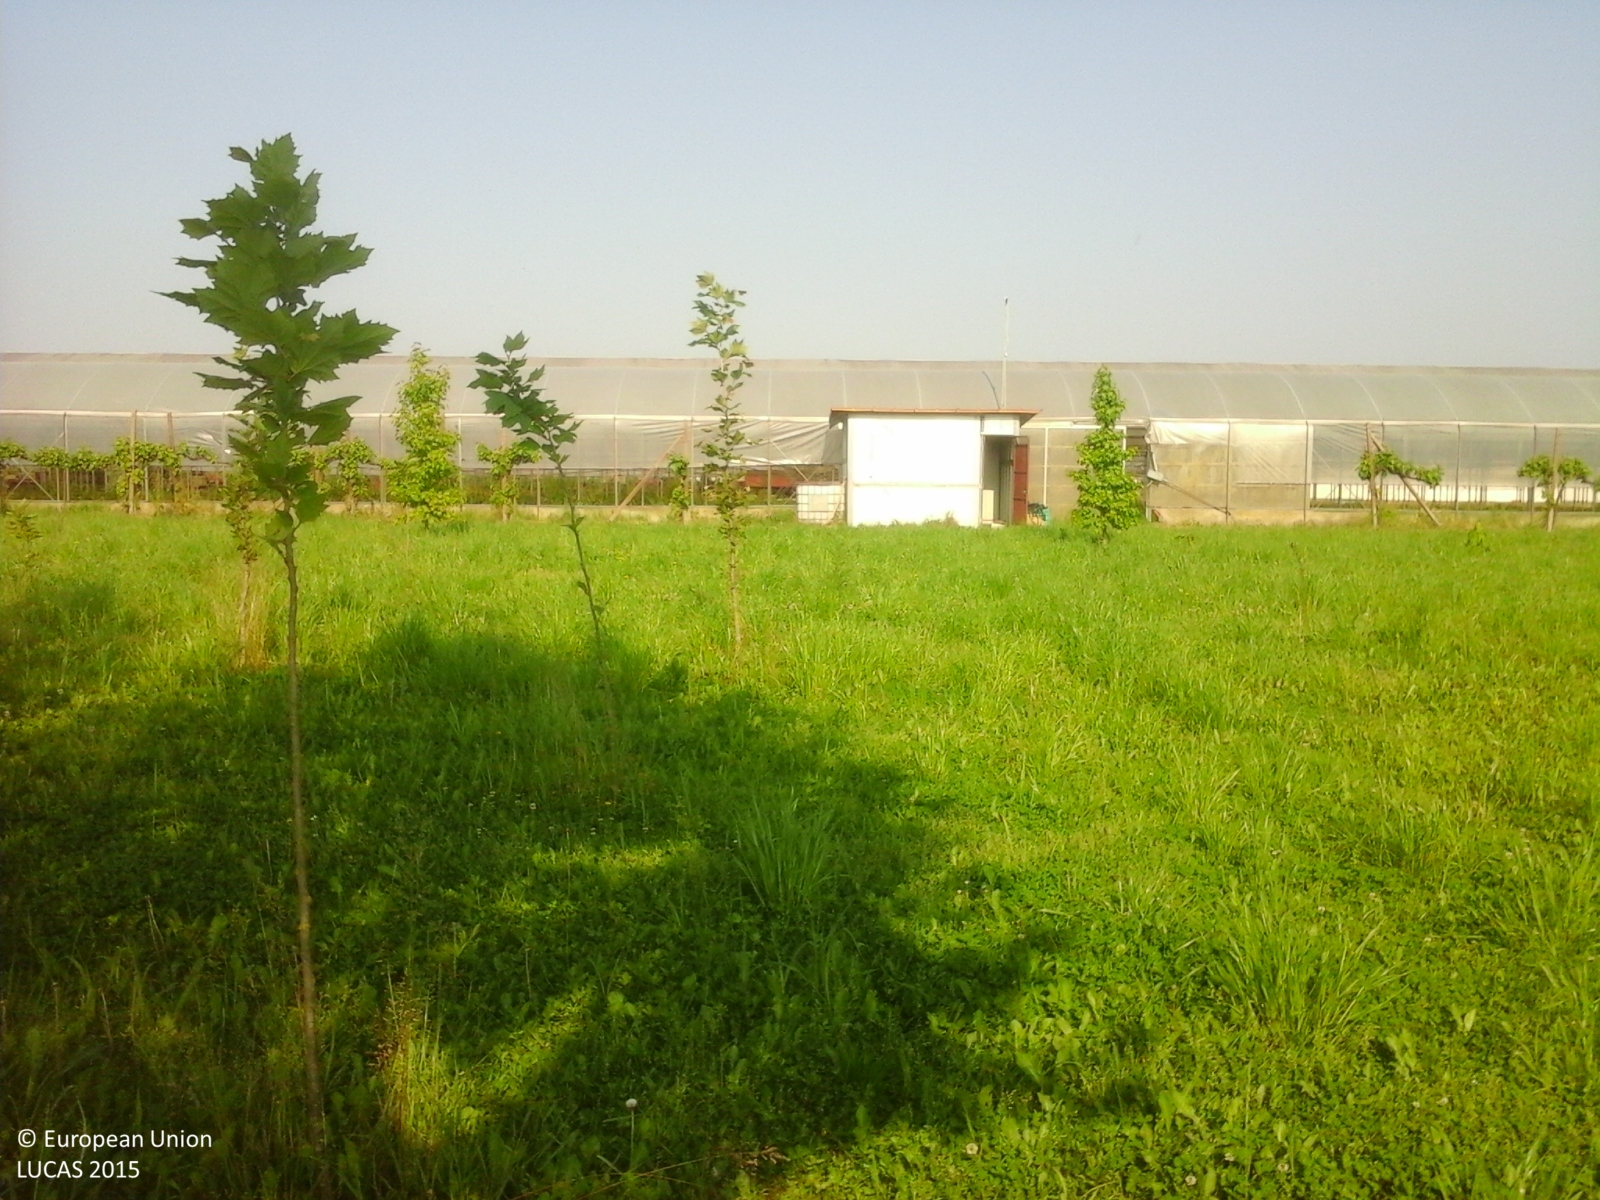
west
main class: Grassland
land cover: Grassland without tree/shrub cover
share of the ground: > 75 %
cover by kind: herbaceous plants 100 %
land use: Agriculture (excluding fallow land and kitchen gardens)
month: May
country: IT
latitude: 45.6129
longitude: 11.9333
